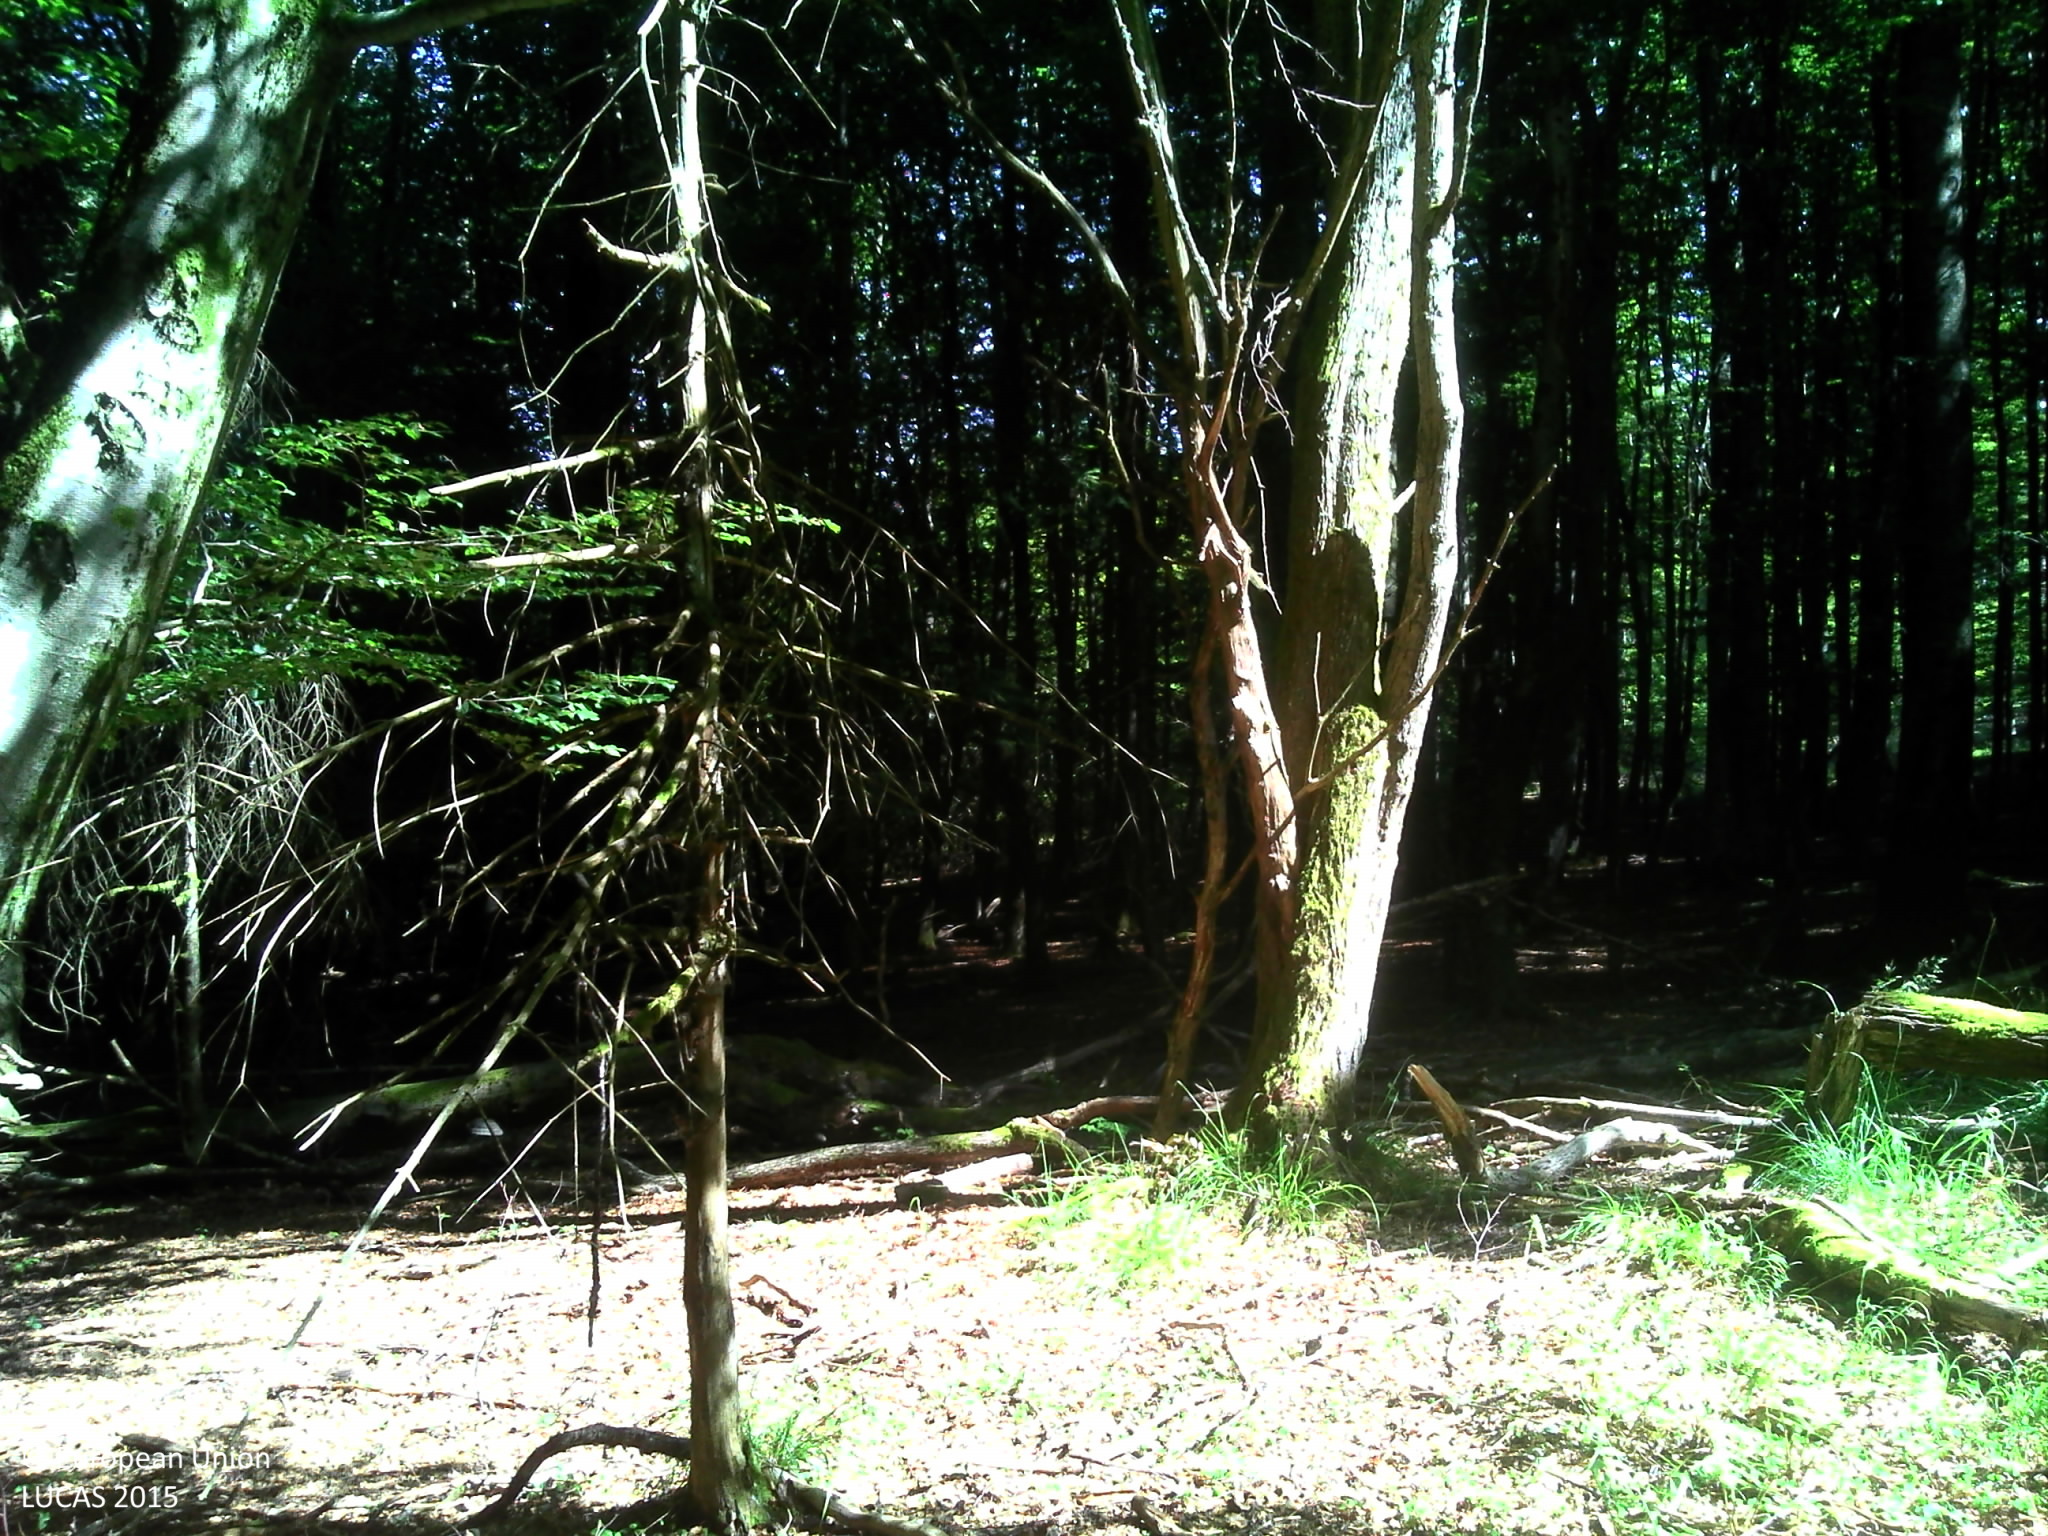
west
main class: Woodland
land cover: Spruce dominated mixed woodland
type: mountainous beech forest
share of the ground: > 75 %
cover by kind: coniferous forest trees 60 %, broadleaved forest trees 35 %, herbaceous plants 5 %
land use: Forestry
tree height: > 5 m
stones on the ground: < 10 %
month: July
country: FR
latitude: 48.4614
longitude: 7.3367
